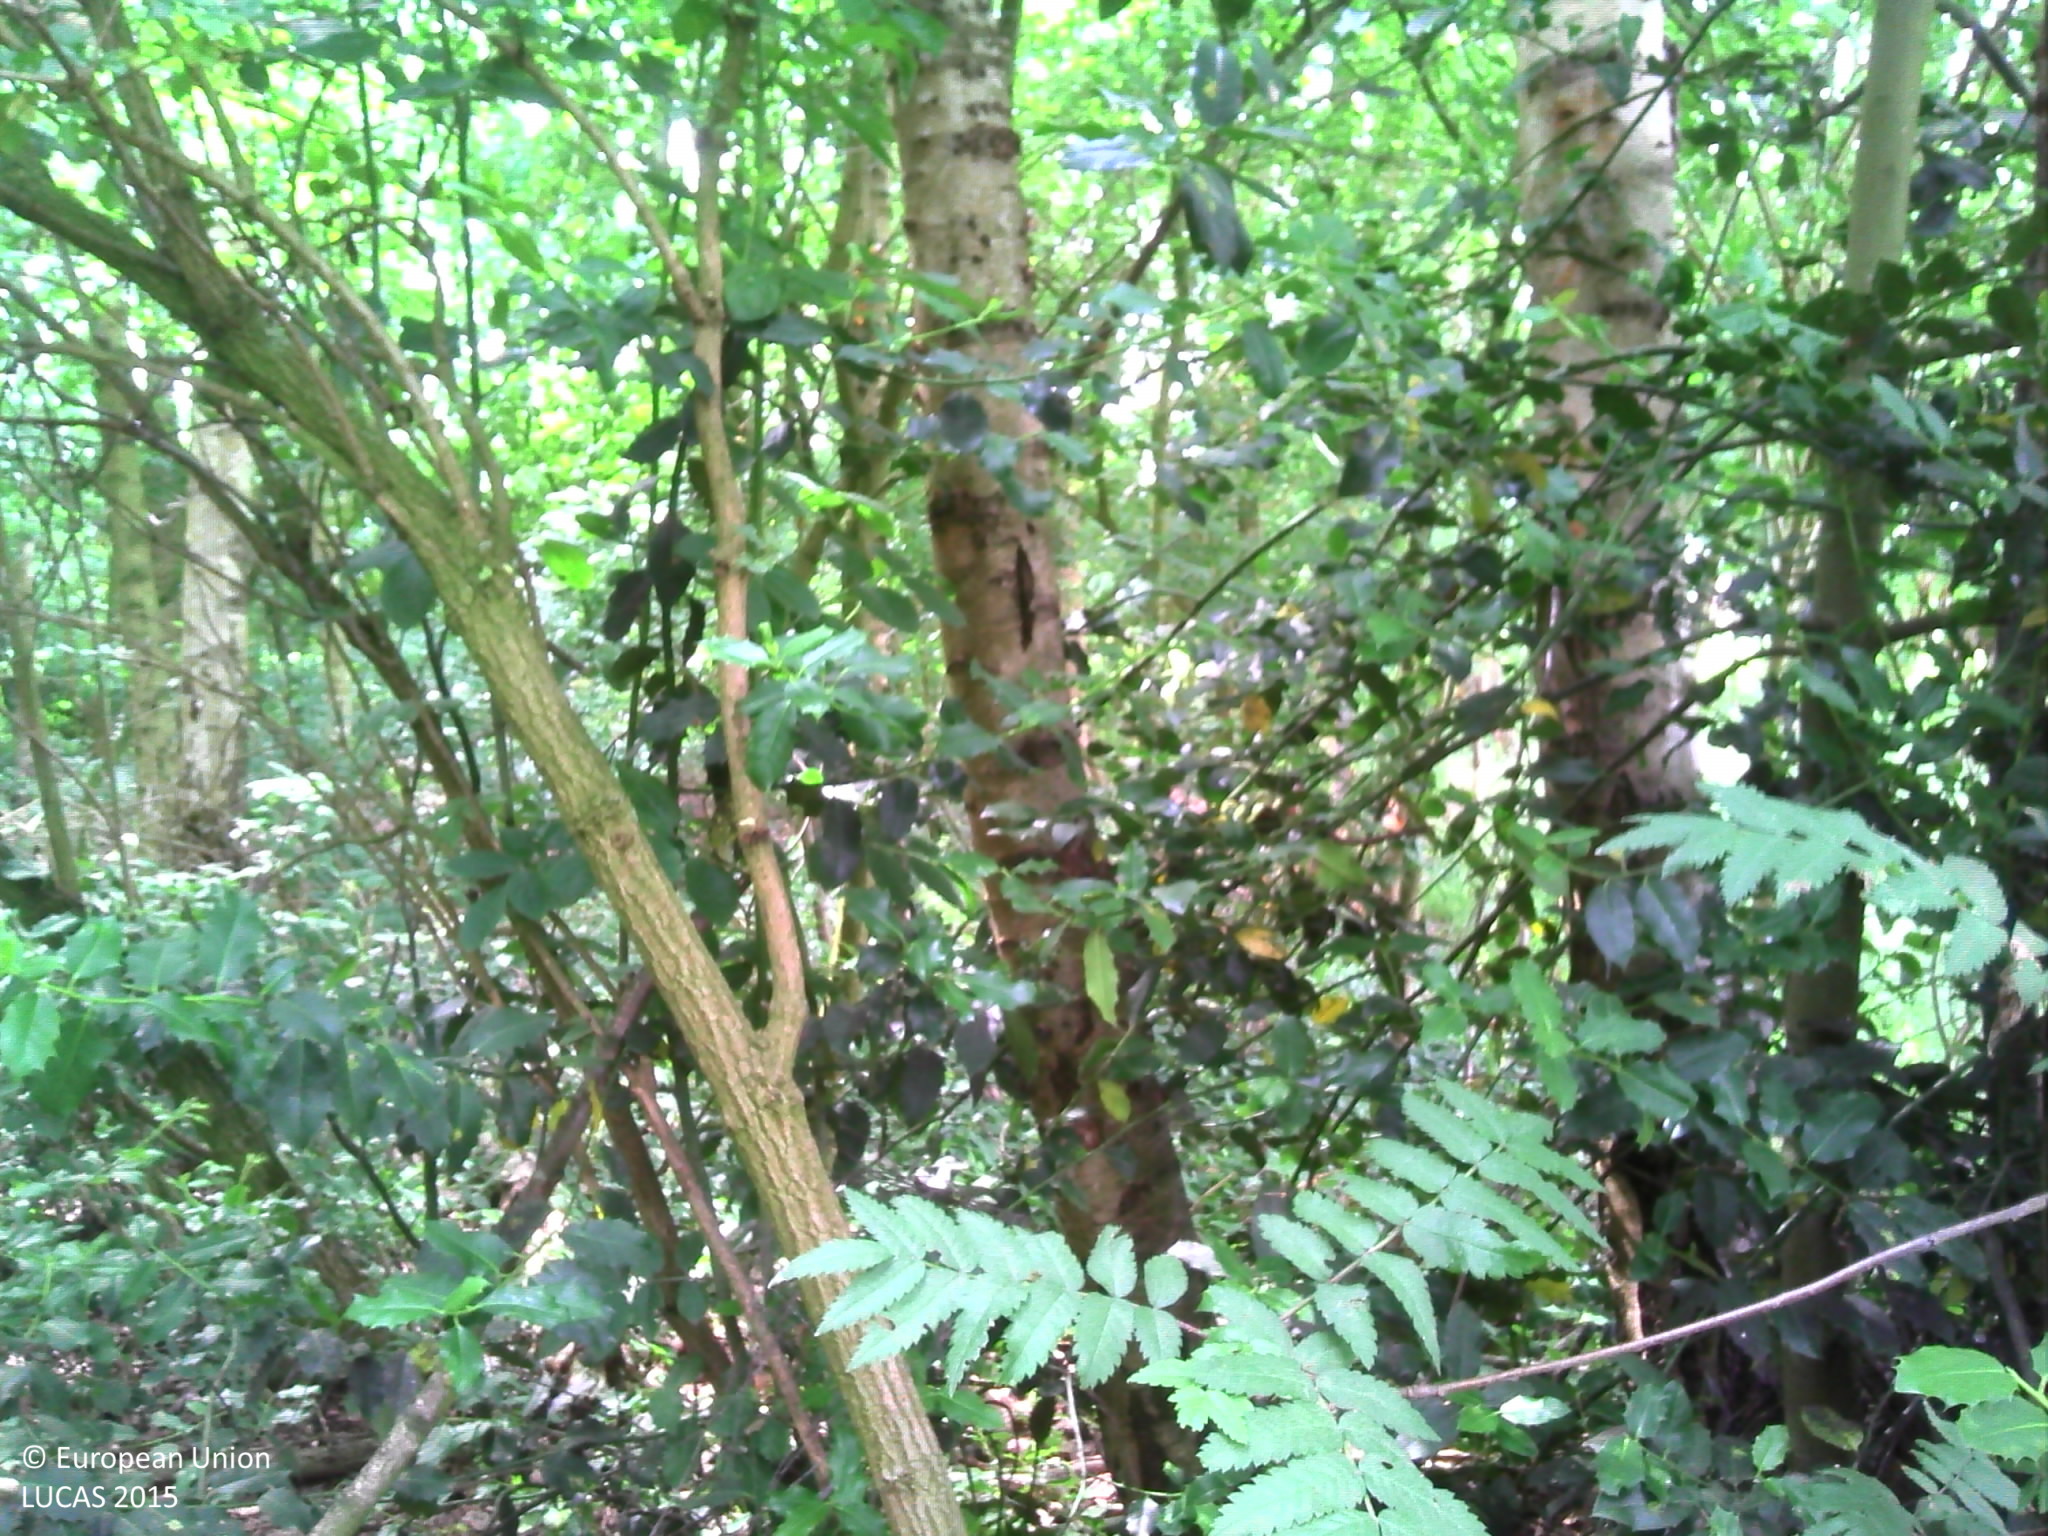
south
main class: Woodland
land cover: Broadleaved woodland
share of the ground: > 75 %
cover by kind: broadleaved forest trees 100 %
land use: Forestry
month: June
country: BE
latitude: 50.9978
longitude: 3.6234
